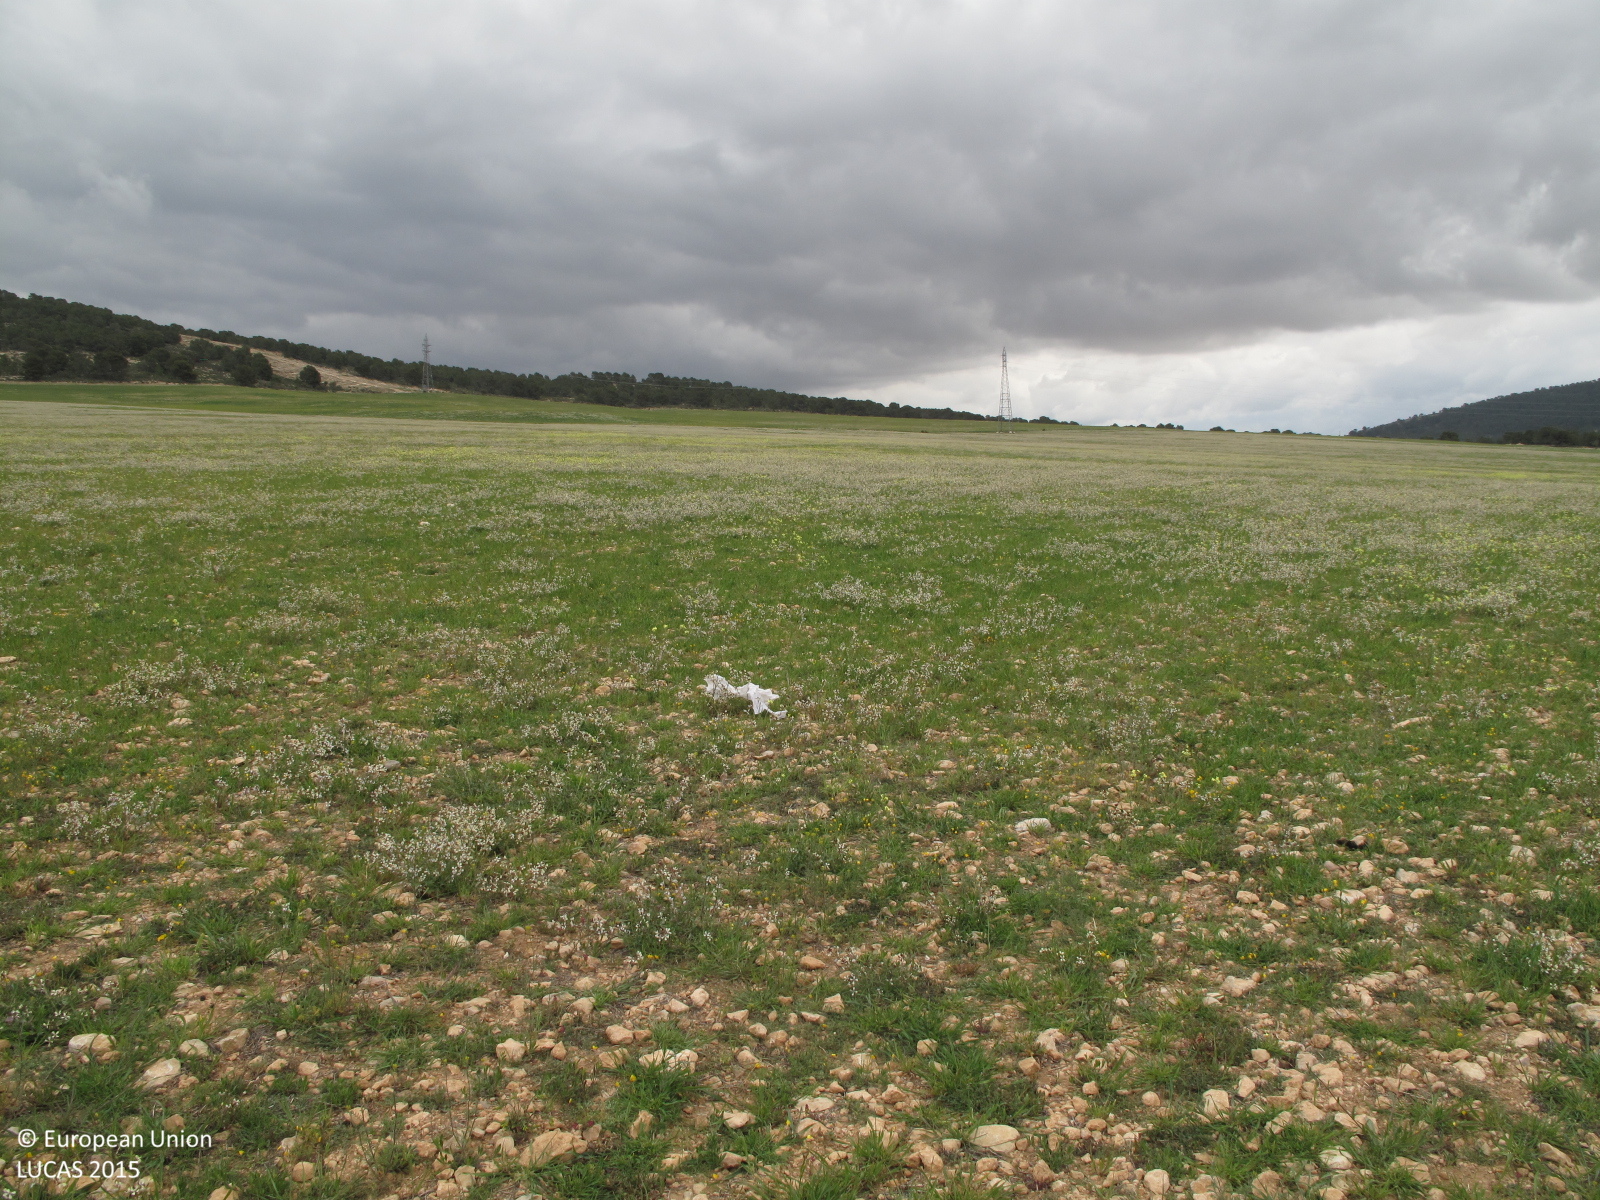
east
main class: Grassland
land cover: Spontaneously vegetated surfaces
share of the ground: > 75 %
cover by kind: herbaceous plants 90 %, unconsolidated bare surface 10 %
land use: Fallow land
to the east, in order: Spontaneously vegetated surfaces
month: April
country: ES
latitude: 38.7929
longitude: -0.9647
